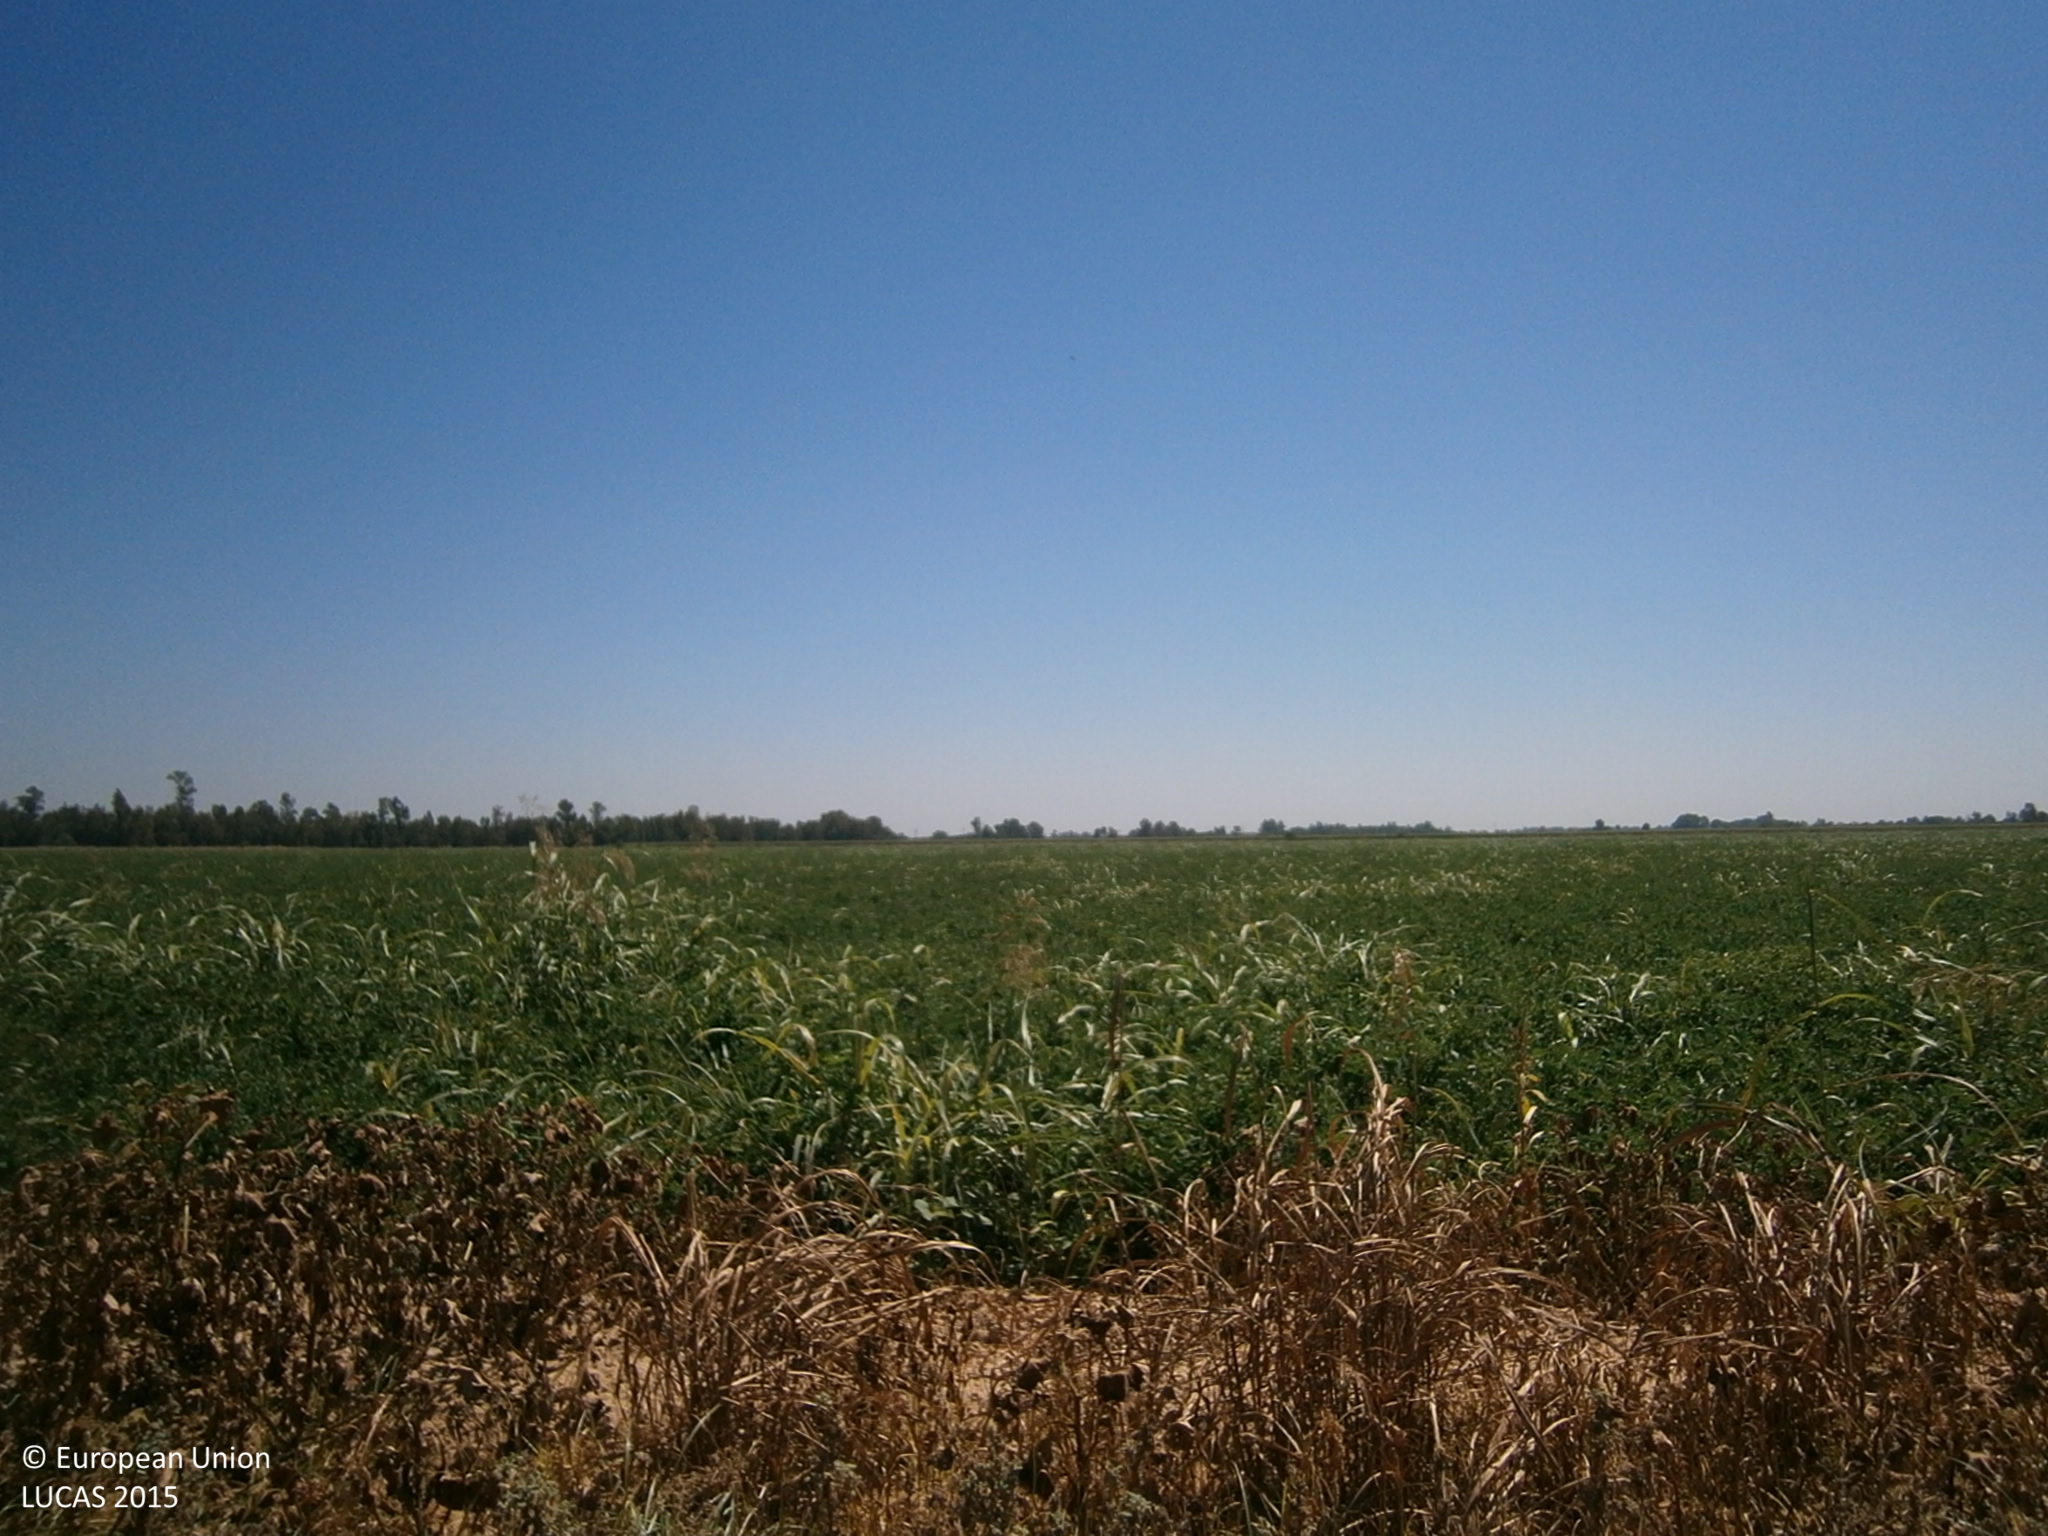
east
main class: Cropland
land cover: Maize
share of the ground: > 75 %
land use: Agriculture (excluding fallow land and kitchen gardens)
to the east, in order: Maize
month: July
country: ES
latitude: 38.9229
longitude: -6.8739
